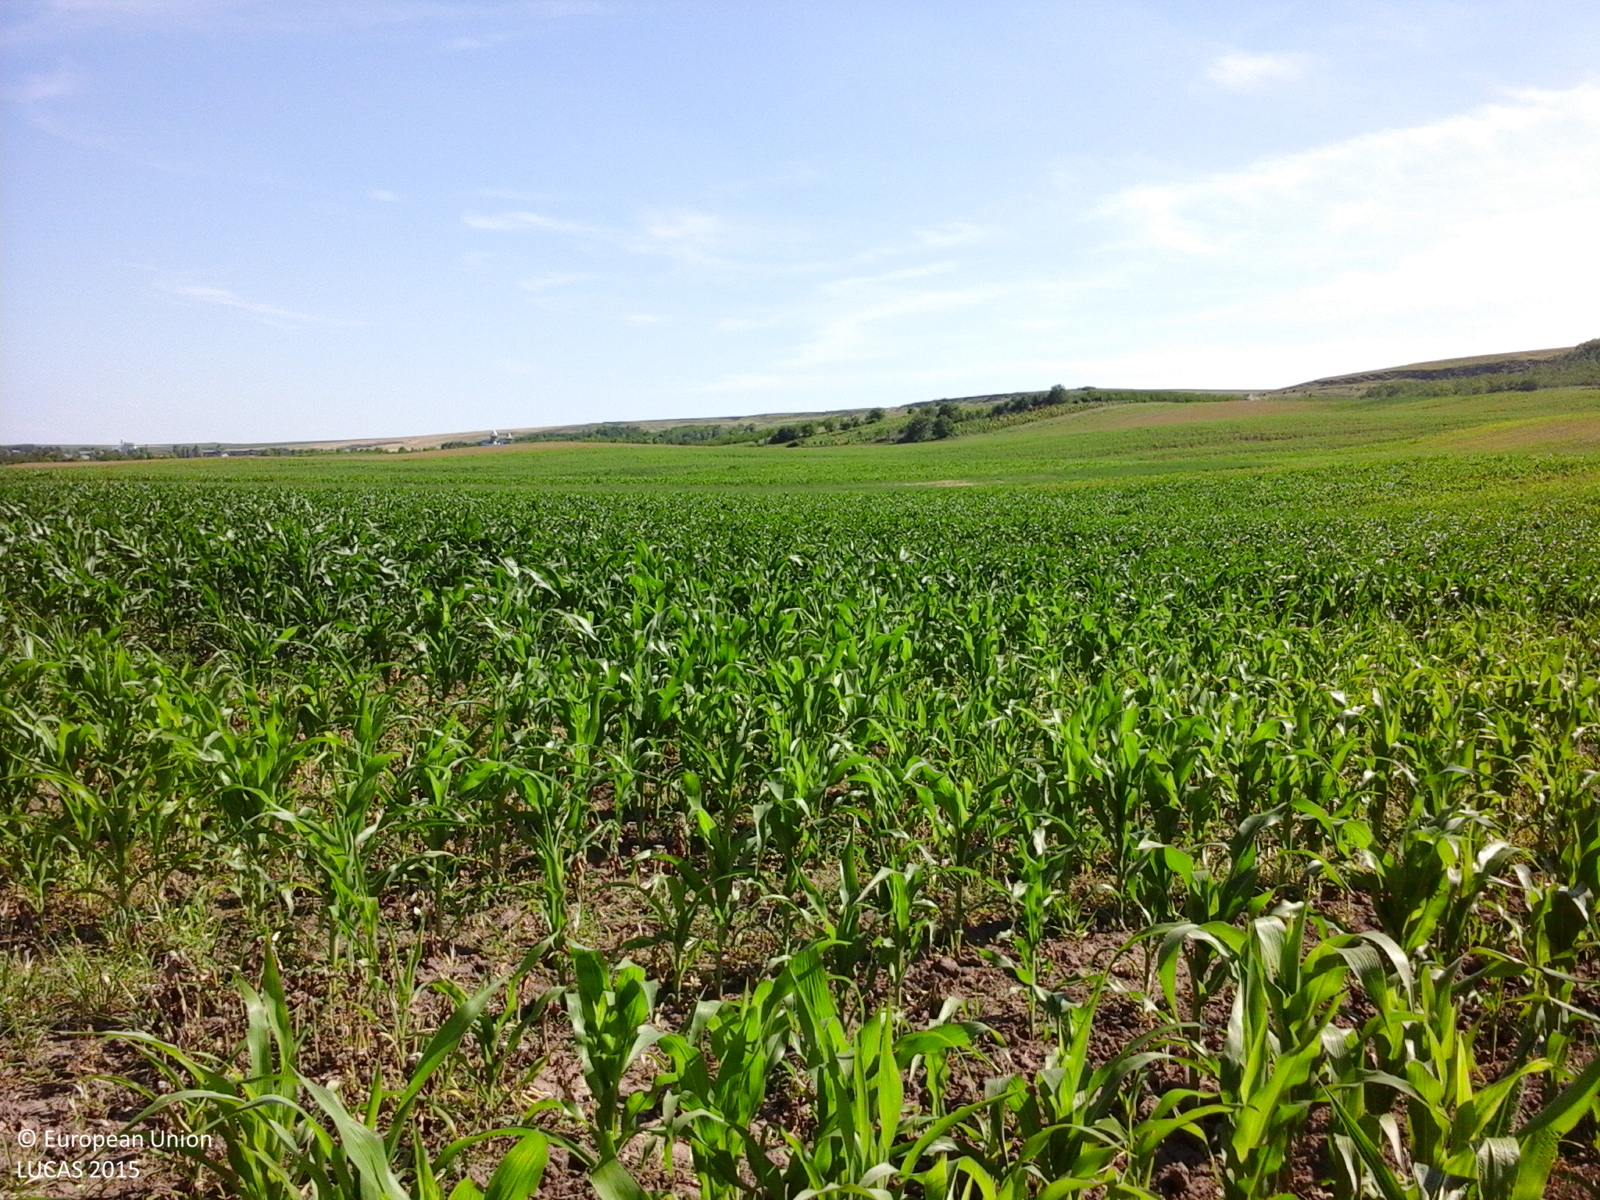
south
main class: Cropland
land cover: Maize
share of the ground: > 75 %
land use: Agriculture (excluding fallow land and kitchen gardens)
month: June
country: RO
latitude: 47.5292
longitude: 27.2588
